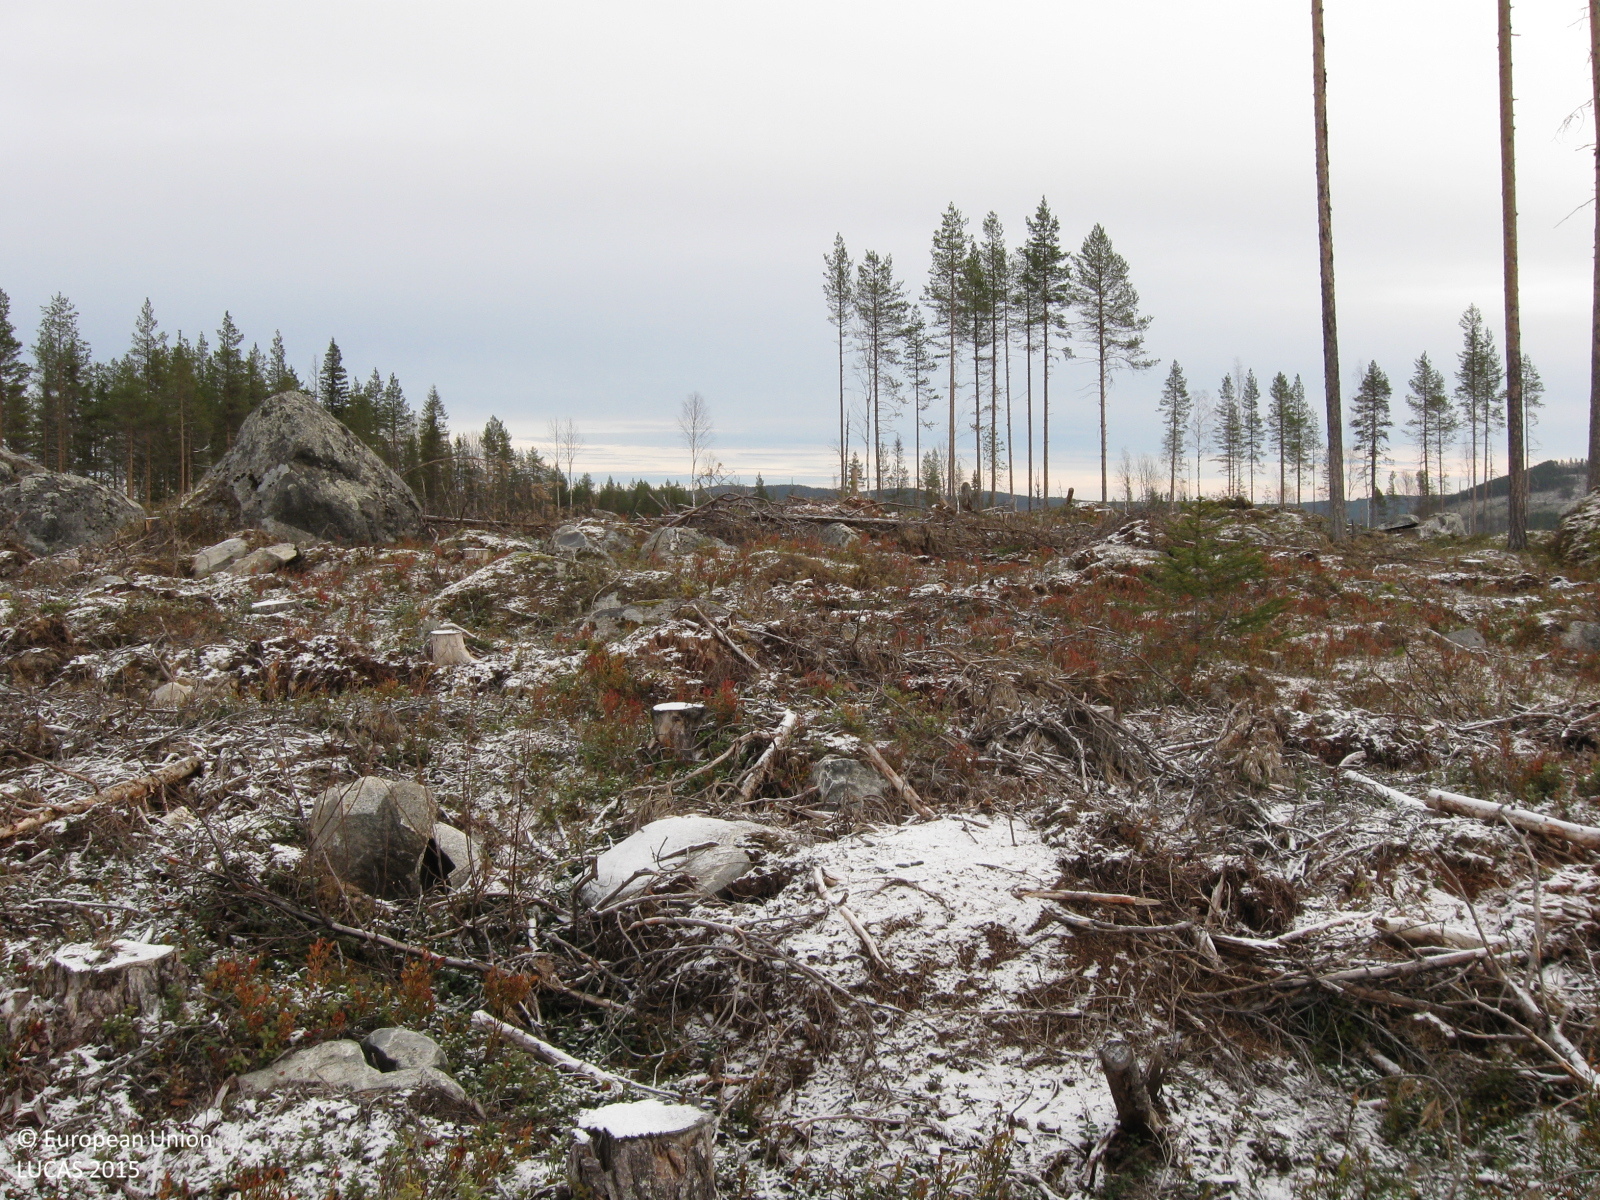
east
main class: Shrubland
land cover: Shrubland with sparse tree cover
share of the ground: 25 - 50 %
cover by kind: shrubs 45 %, consolidated bare surface 15 %, herbaceous plants 10 %, lichens and mosses 10 %, coniferous forest trees 5 %, unconsolidated bare surface 5 %
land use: Forestry
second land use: Amenities, museums, leisure
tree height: < 5 m
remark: Clear cut
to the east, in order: Shrubland with sparse tree cover; Pine dominated coniferous woodland; Shrubland with sparse tree cover
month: October
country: SE
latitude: 66.2125
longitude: 21.4973
